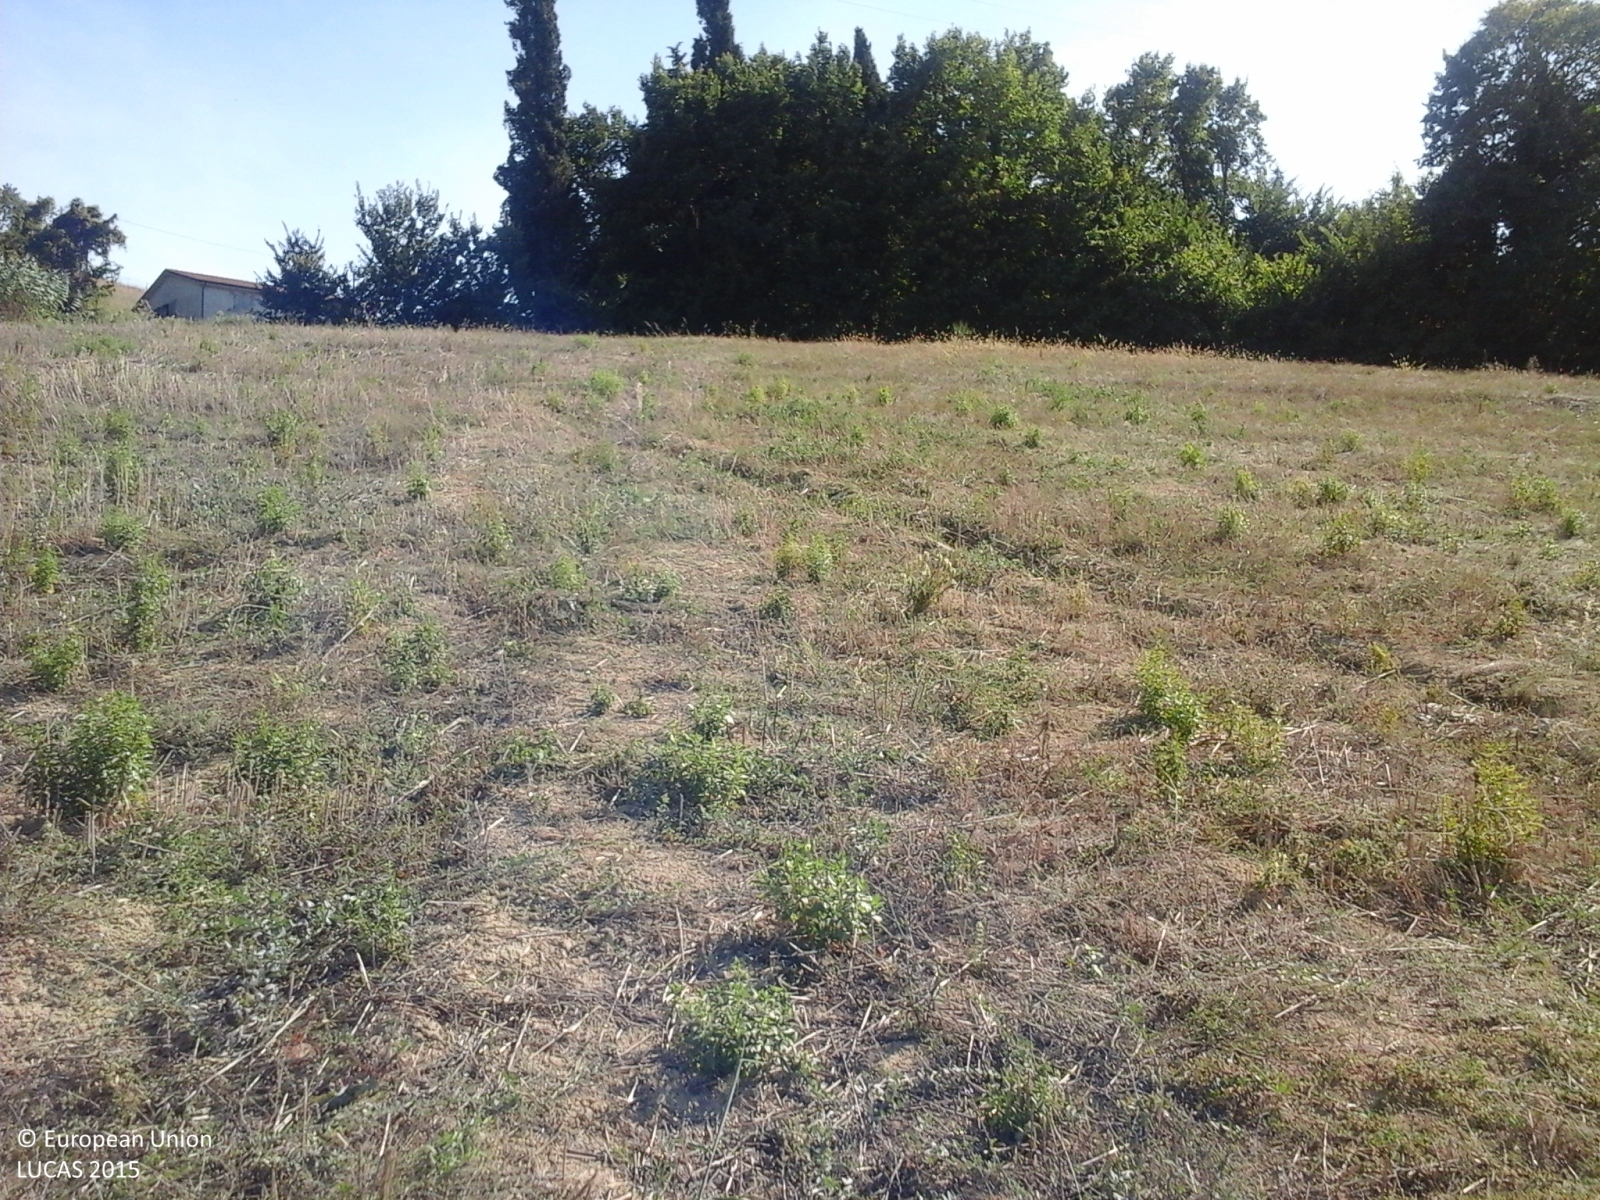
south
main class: Grassland
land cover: Spontaneously vegetated surfaces
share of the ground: > 75 %
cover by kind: herbaceous plants 80 %, unconsolidated bare surface 20 %
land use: Agriculture (excluding fallow land and kitchen gardens)
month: September
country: IT
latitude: 43.8209
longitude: 12.9647
